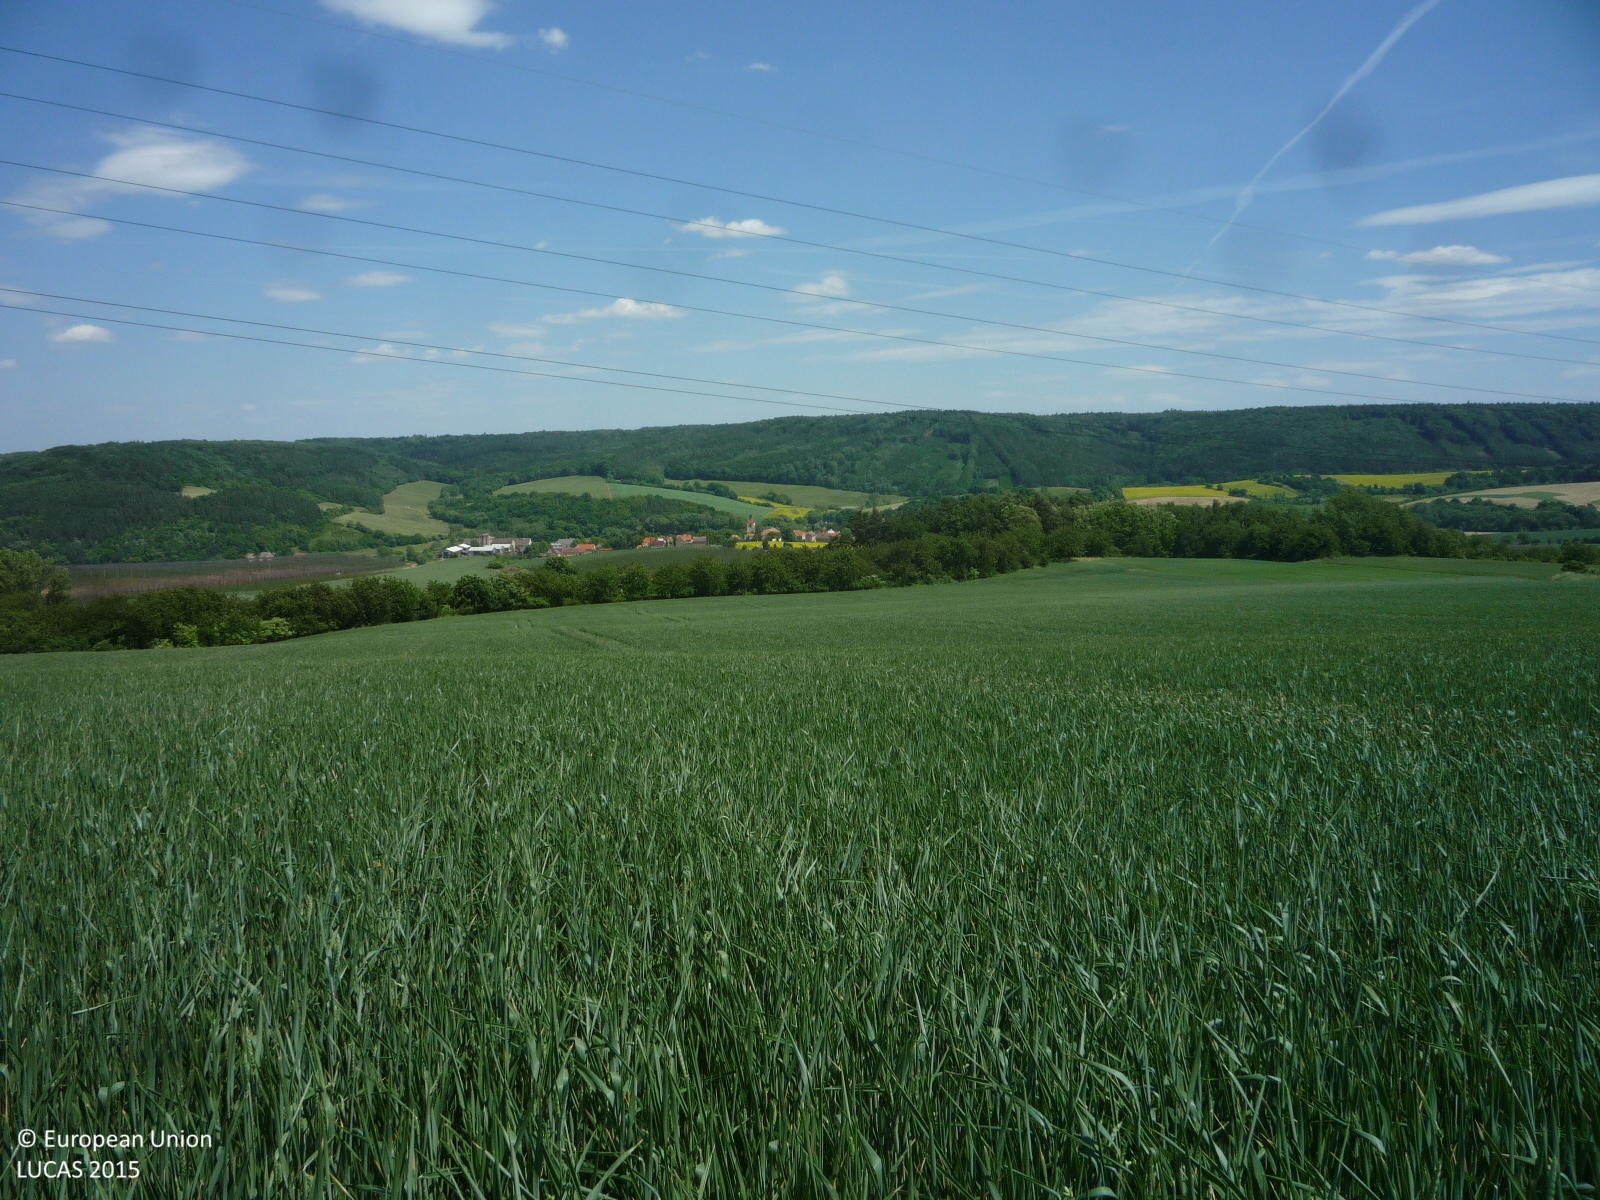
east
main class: Cropland
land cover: Common wheat
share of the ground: > 75 %
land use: Agriculture (excluding fallow land and kitchen gardens)
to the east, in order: Common wheat; Electric lines; Common wheat
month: June
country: CZ
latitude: 50.2649
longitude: 13.8024
